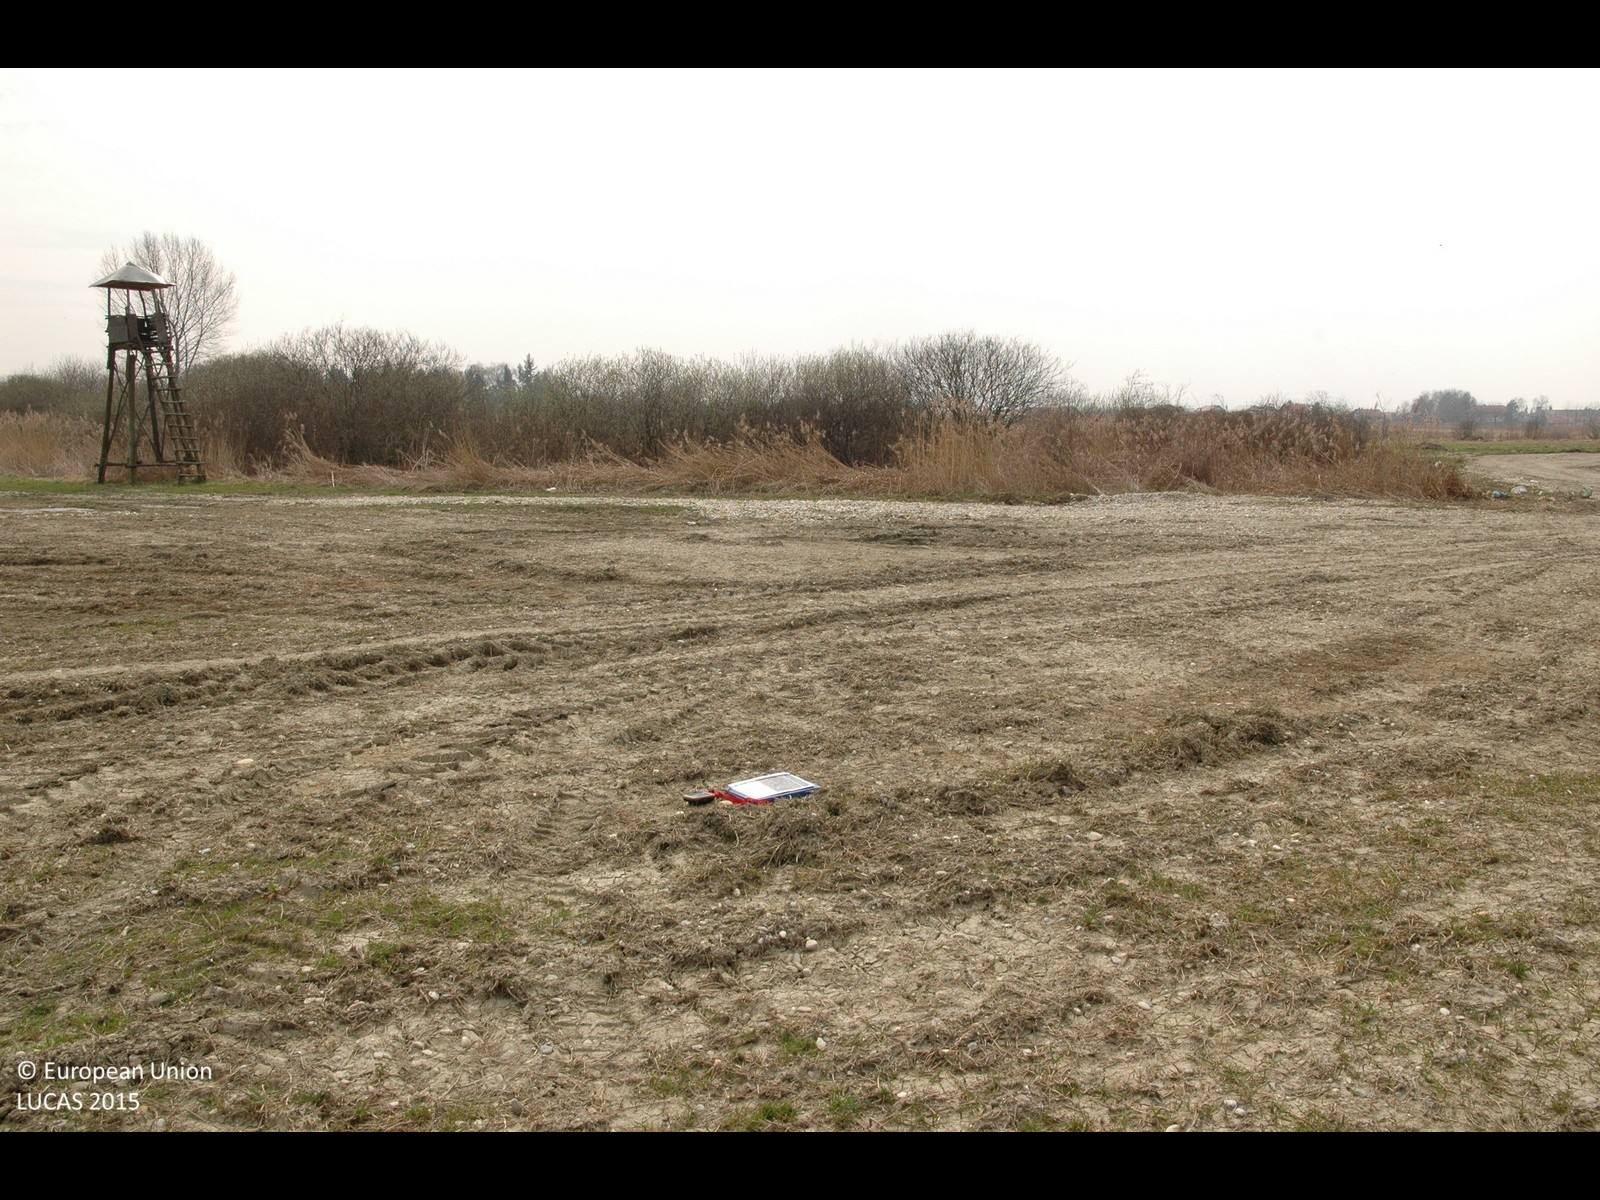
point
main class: Grassland
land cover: Spontaneously vegetated surfaces
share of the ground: > 75 %
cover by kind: herbaceous plants 100 %
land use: Agriculture (excluding fallow land and kitchen gardens)
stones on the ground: < 10 %
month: March
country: HR
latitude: 46.2860
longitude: 16.3991
